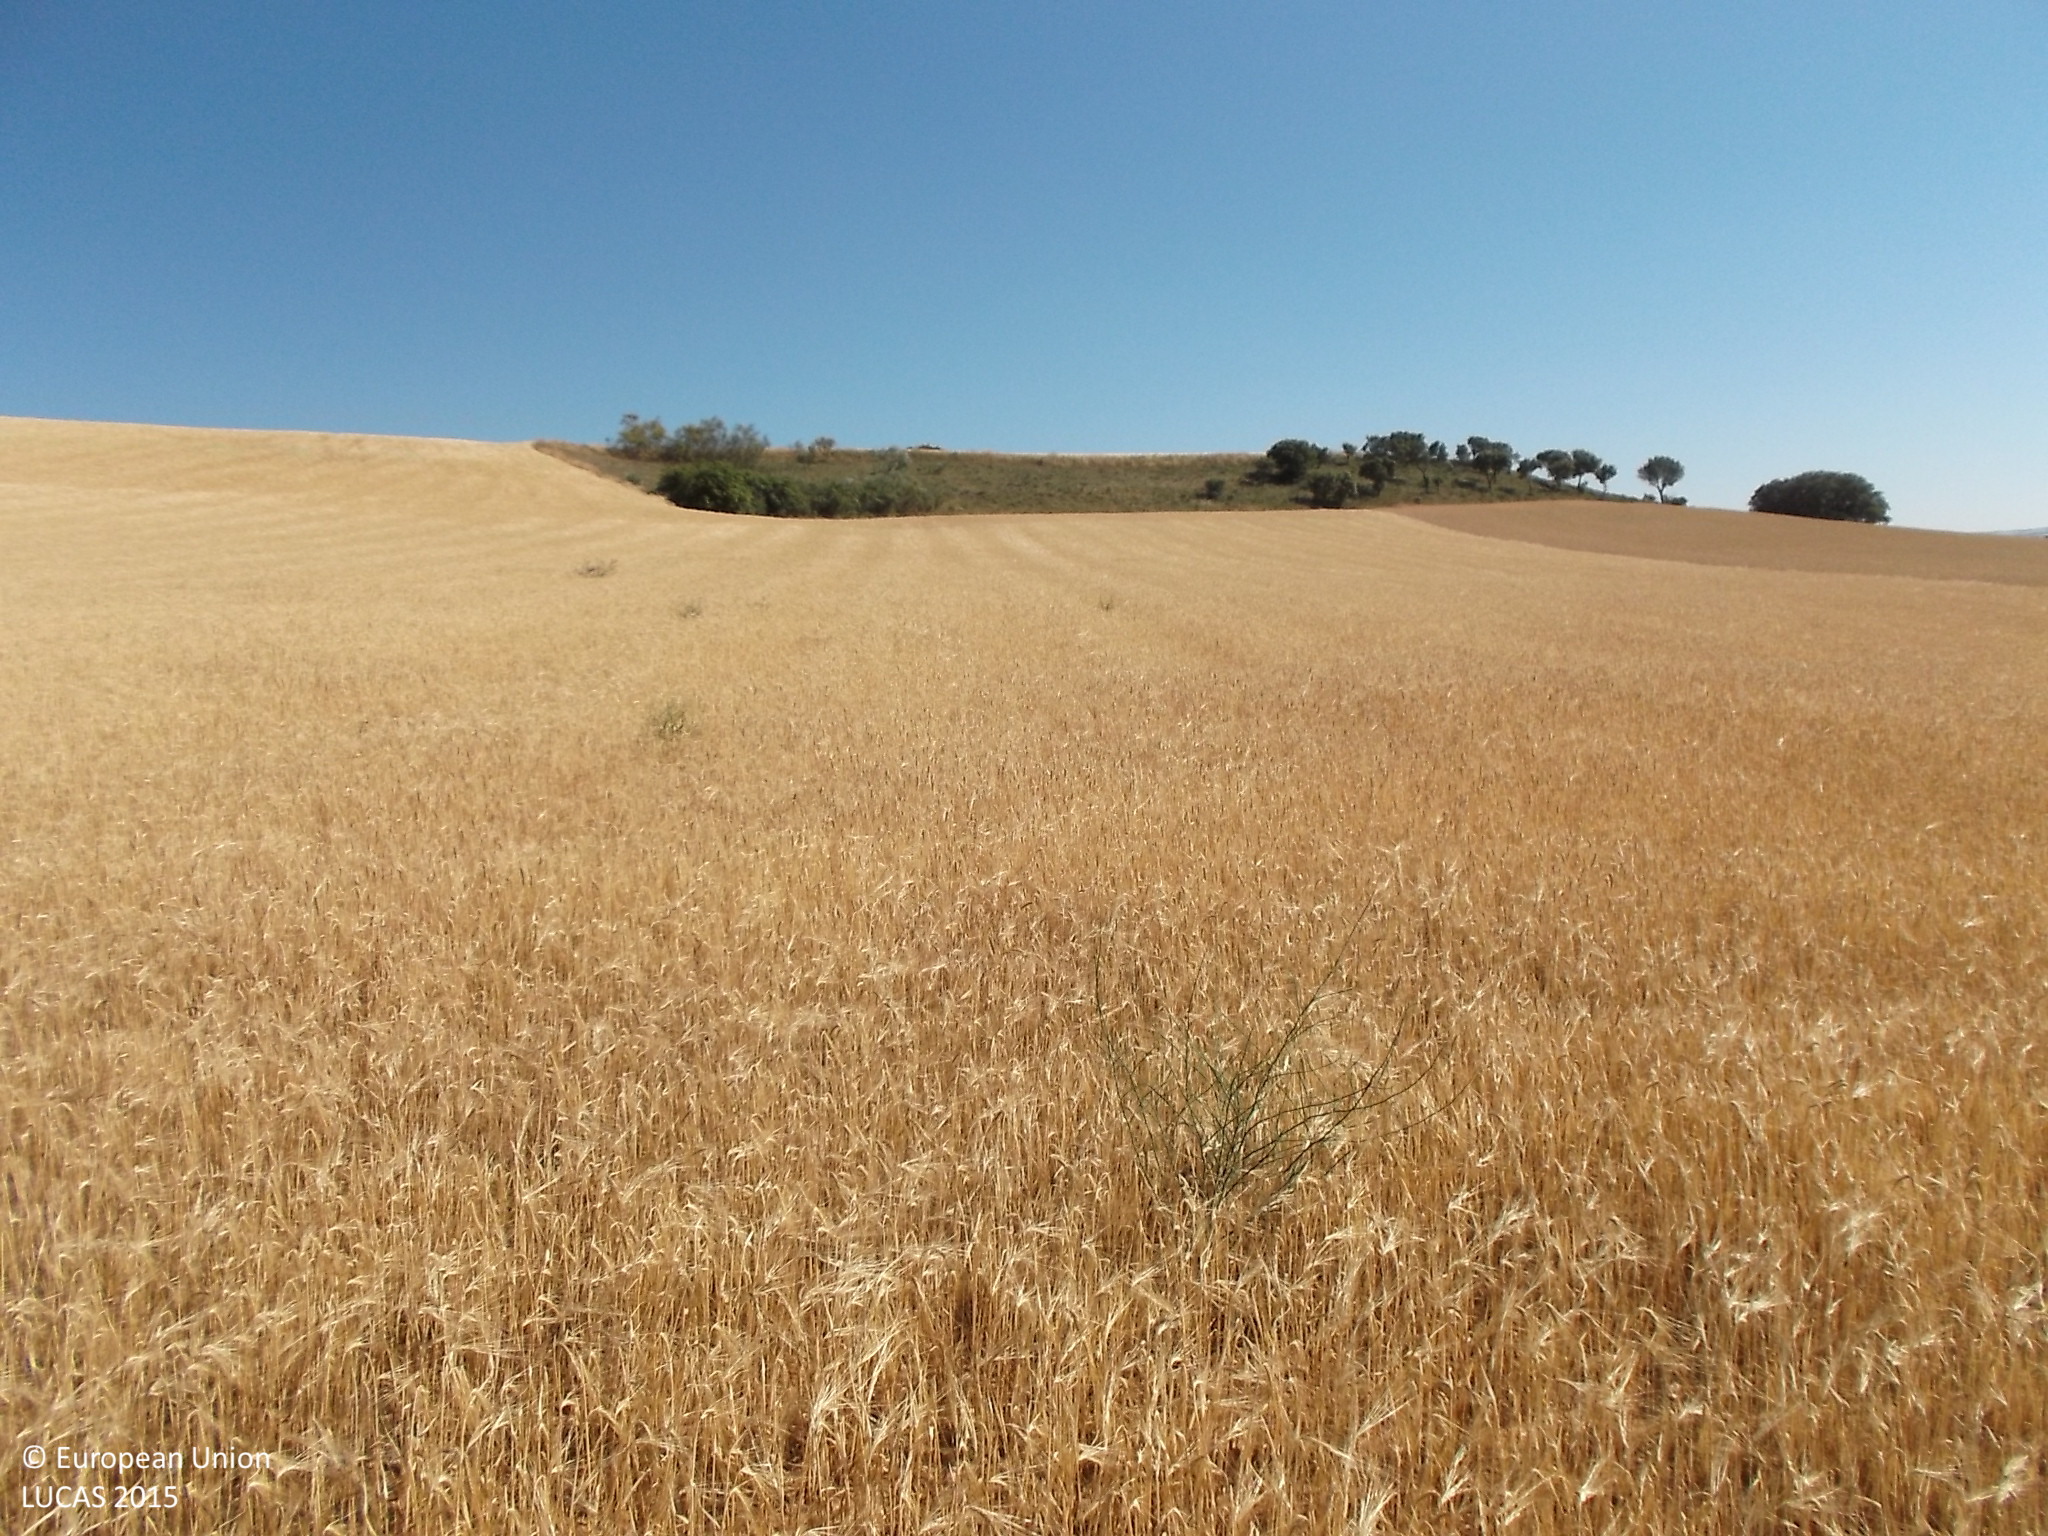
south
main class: Cropland
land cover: Barley
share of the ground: > 75 %
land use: Agriculture (excluding fallow land and kitchen gardens)
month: June
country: ES
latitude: 41.3315
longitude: -5.3343
